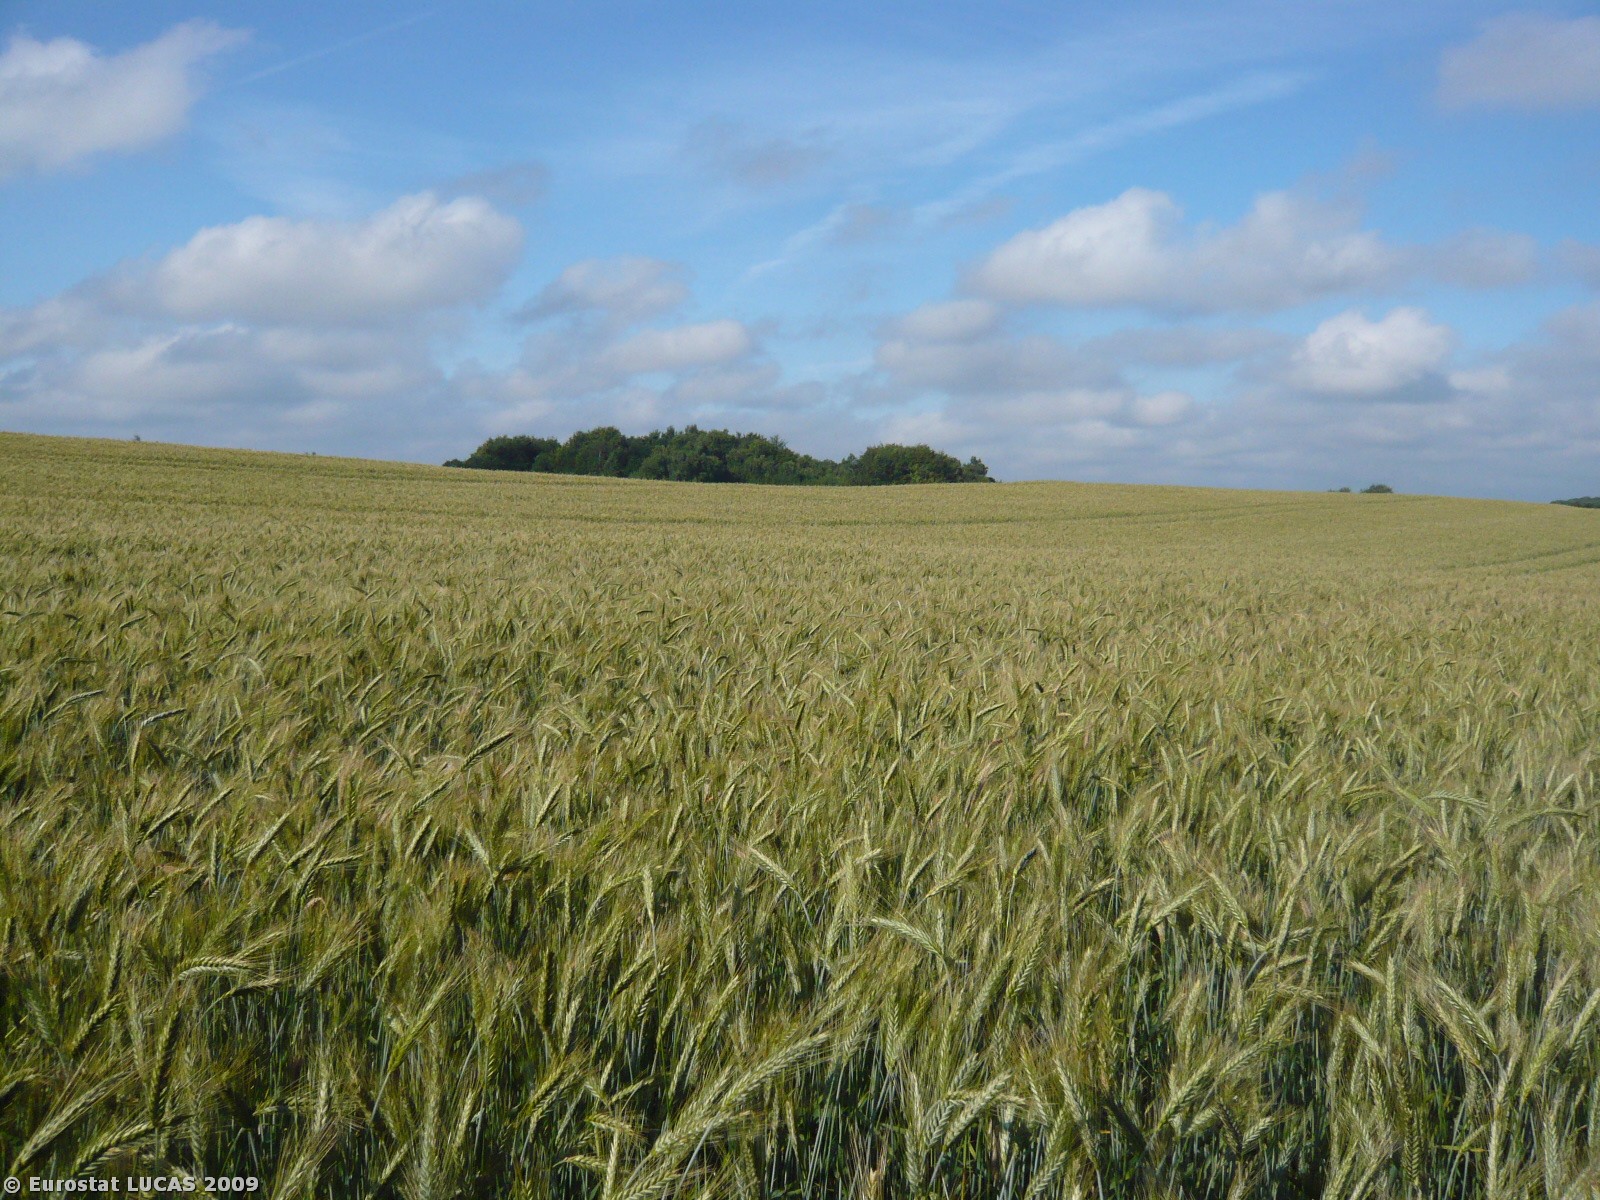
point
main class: Cropland
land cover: Triticale
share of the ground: > 75 %
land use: Agriculture (excluding fallow land and kitchen gardens)
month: June
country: DK
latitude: 55.2170
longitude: 10.1728
